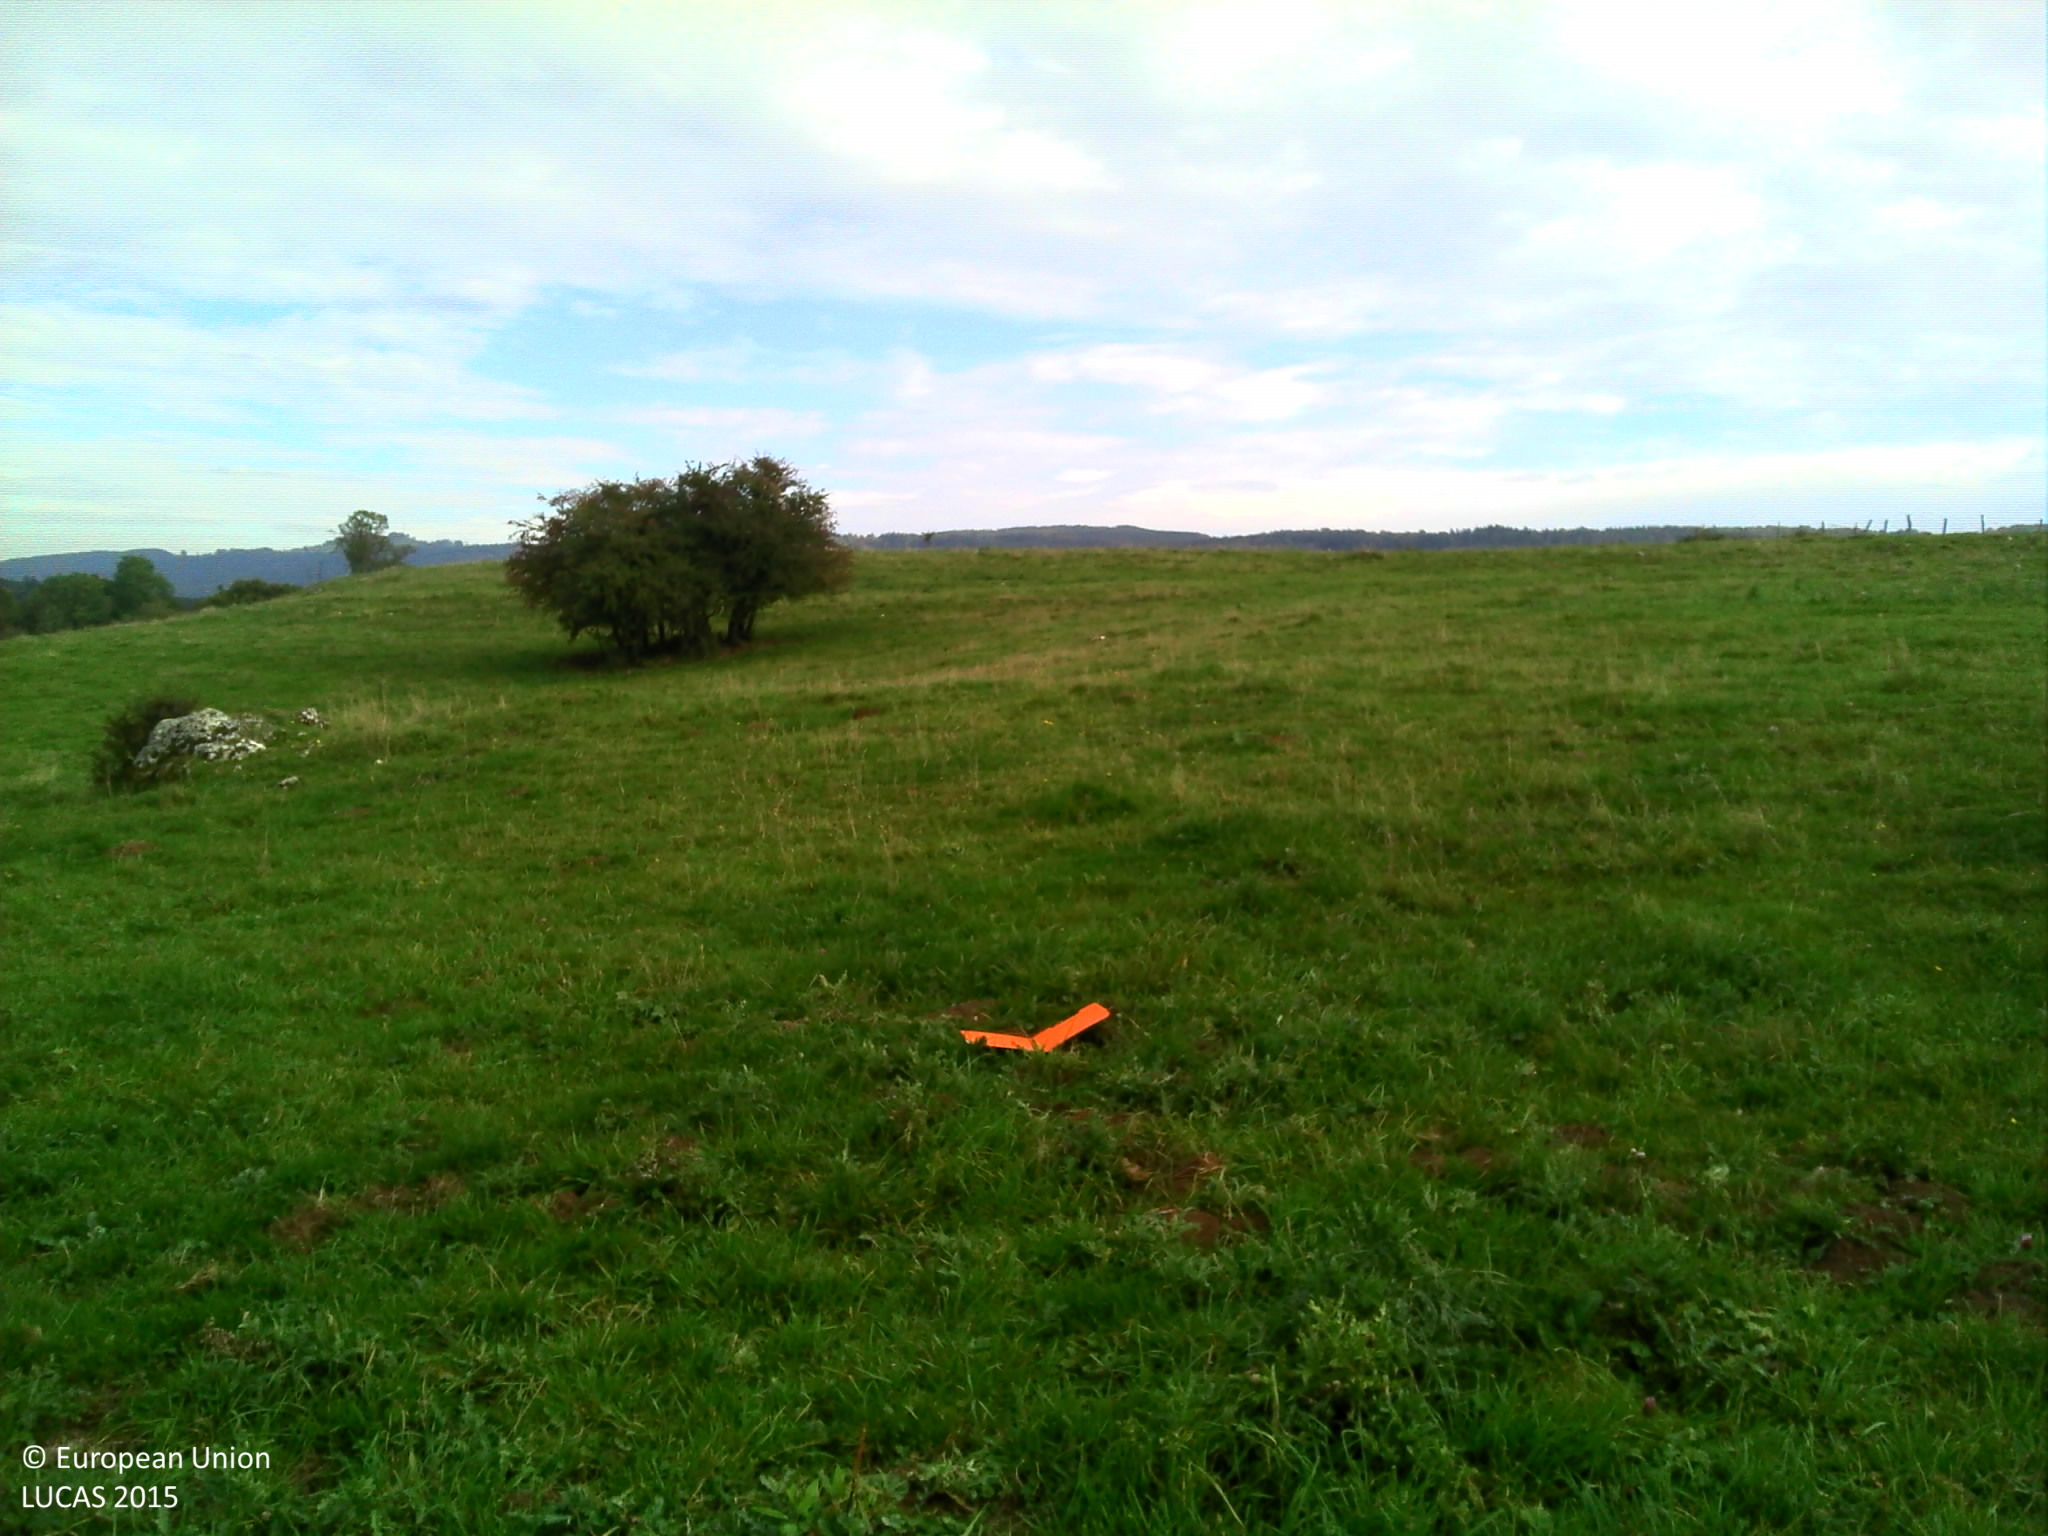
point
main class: Grassland
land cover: Grassland with sparse tree/shrub cover
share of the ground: > 75 %
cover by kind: herbaceous plants 95 %, broadleaved forest trees 5 %
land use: Agriculture (excluding fallow land and kitchen gardens)
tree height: > 5 m
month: October
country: FR
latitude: 47.0454
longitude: 6.3299
